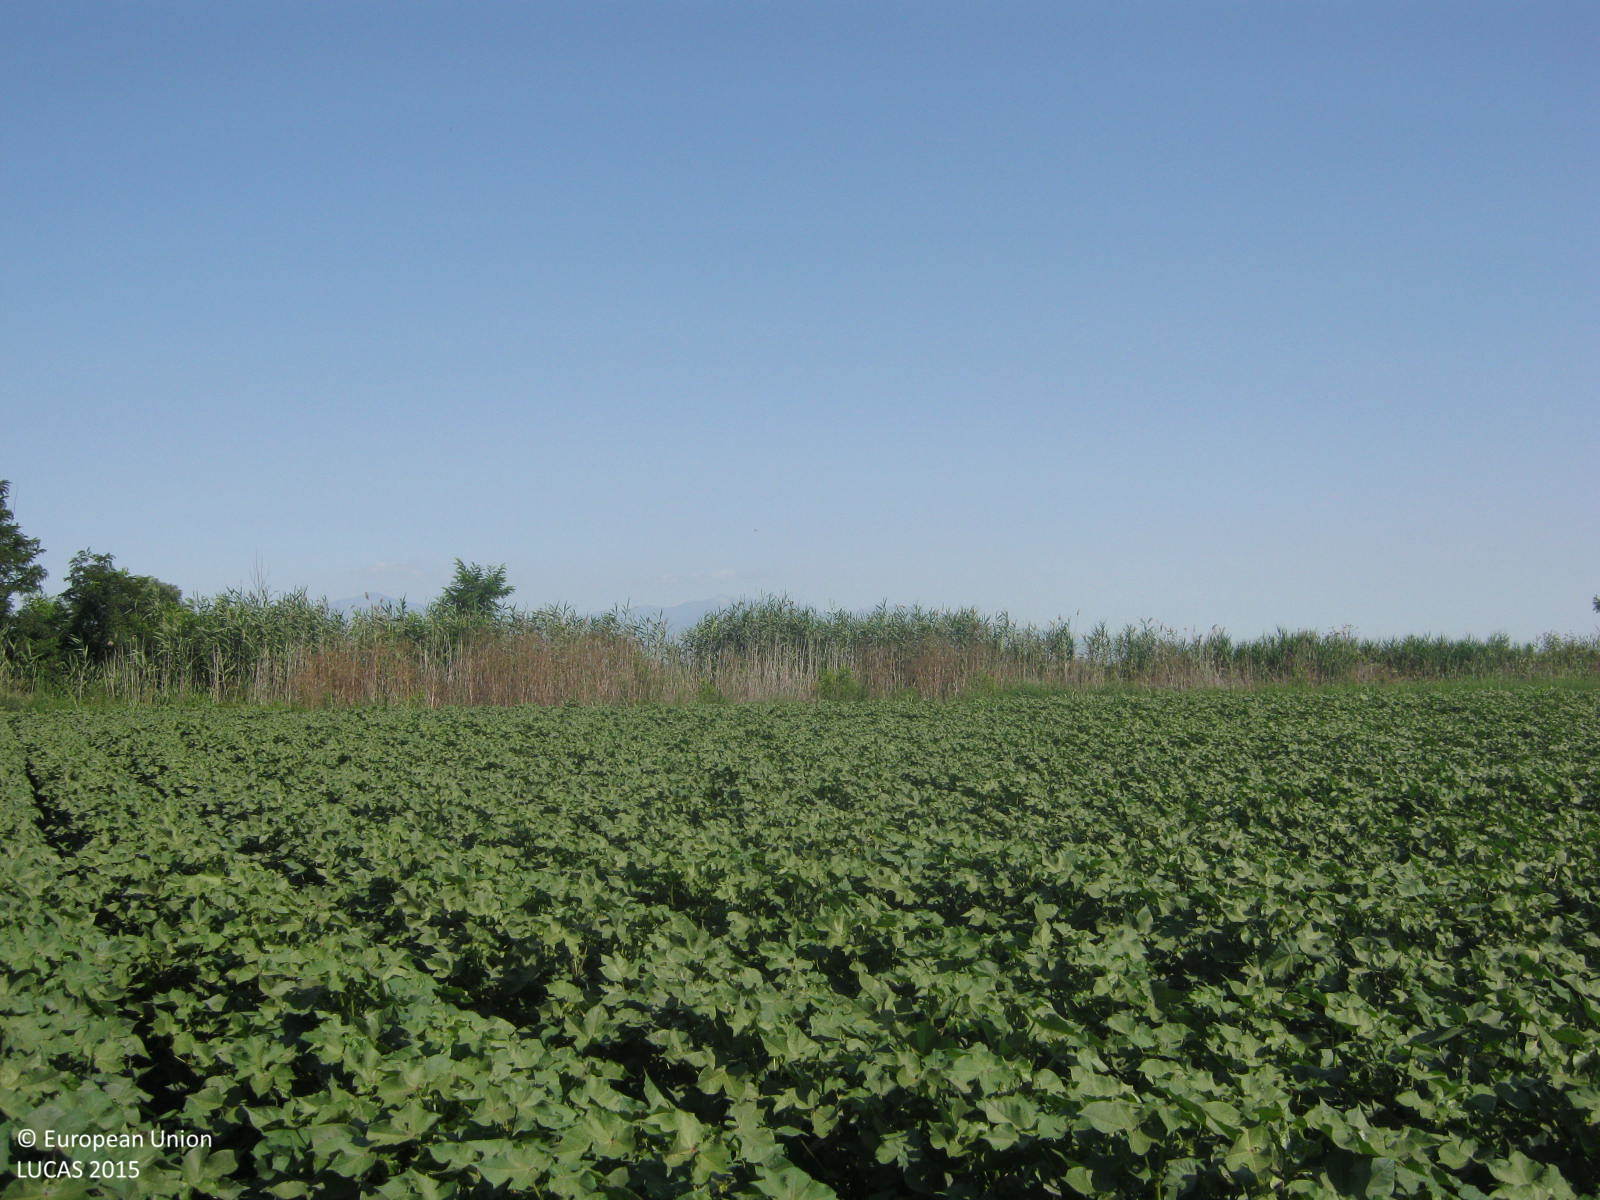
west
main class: Cropland
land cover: Cotton
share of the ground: > 75 %
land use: Agriculture (excluding fallow land and kitchen gardens)
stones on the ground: < 10 %
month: July
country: GR
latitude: 40.6850
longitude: 22.5336
